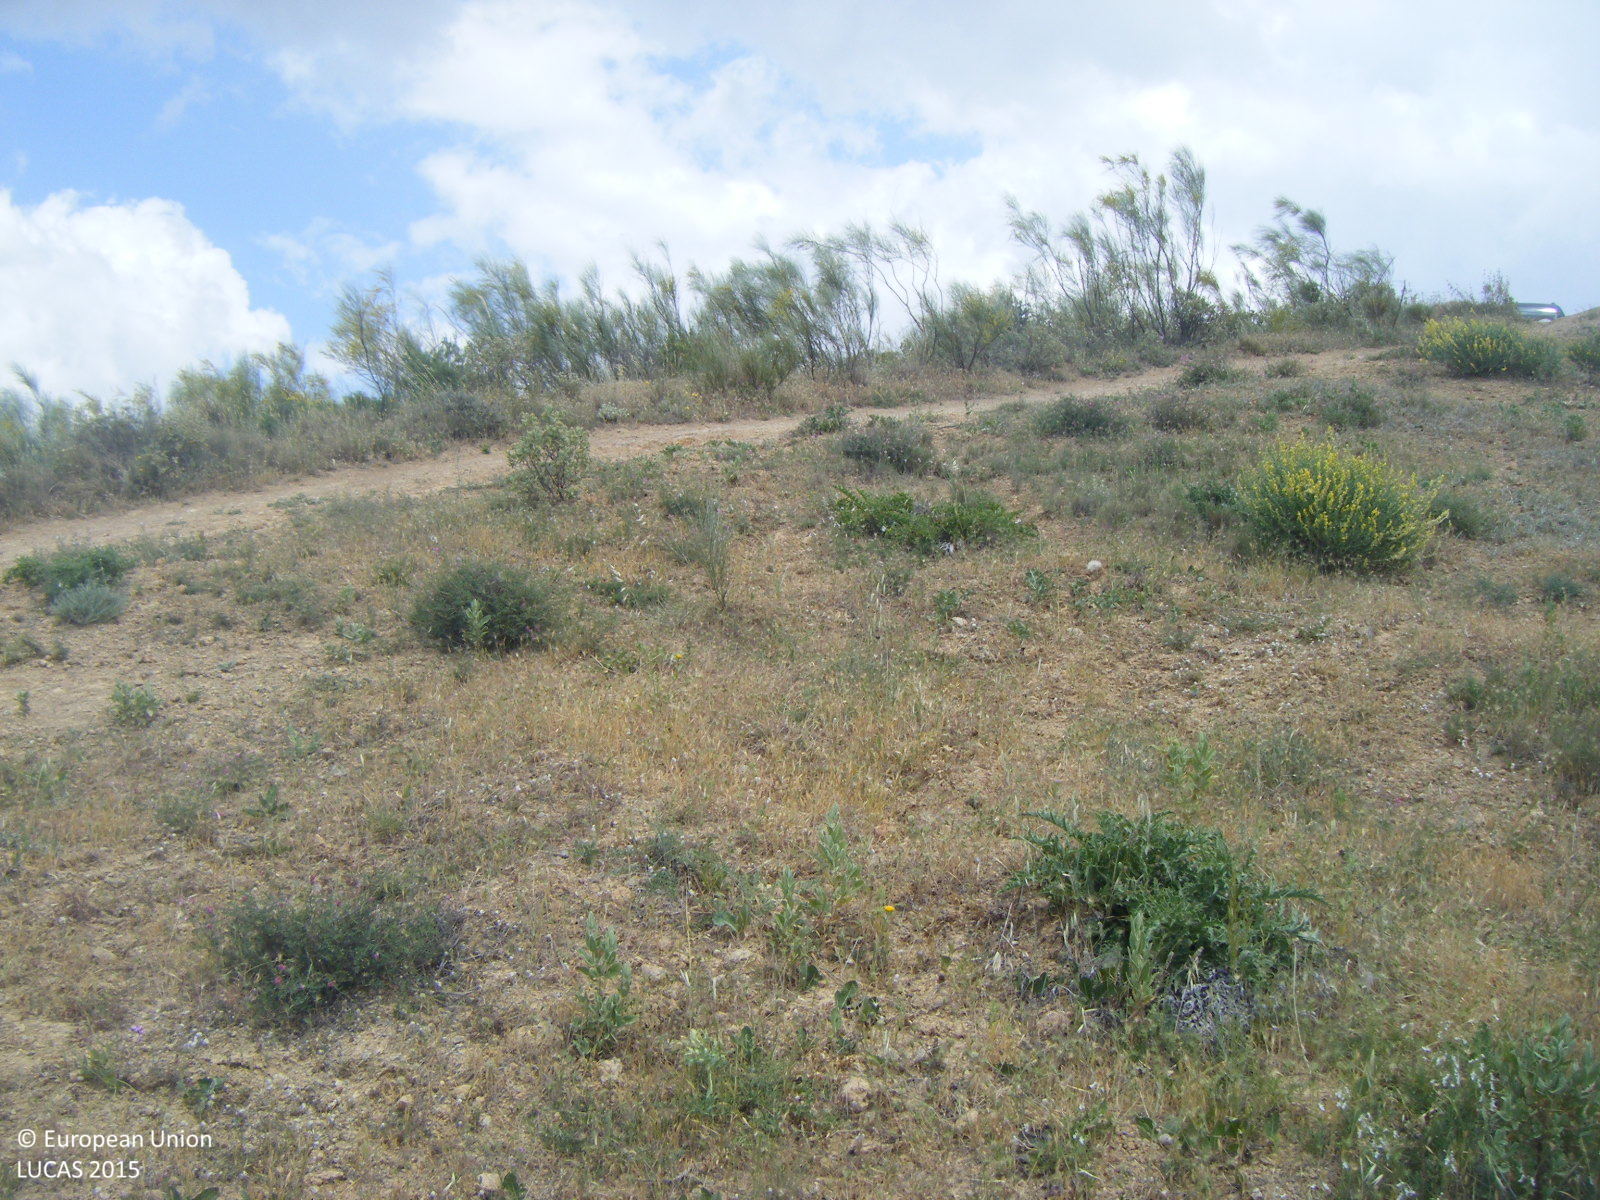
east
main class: Woodland
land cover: Pine dominated coniferous woodland
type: coniferous forest of the mediterranean region
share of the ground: 25 - 50 %
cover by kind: shrubs 50 %, coniferous forest trees 25 %, herbaceous plants 25 %
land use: Semi-natural and natural areas not in use
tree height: > 5 m
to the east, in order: Pine dominated coniferous woodland; Other bare soil; Grassland with sparse tree/shrub cover
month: May
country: ES
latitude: 37.0678
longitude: -4.4032
